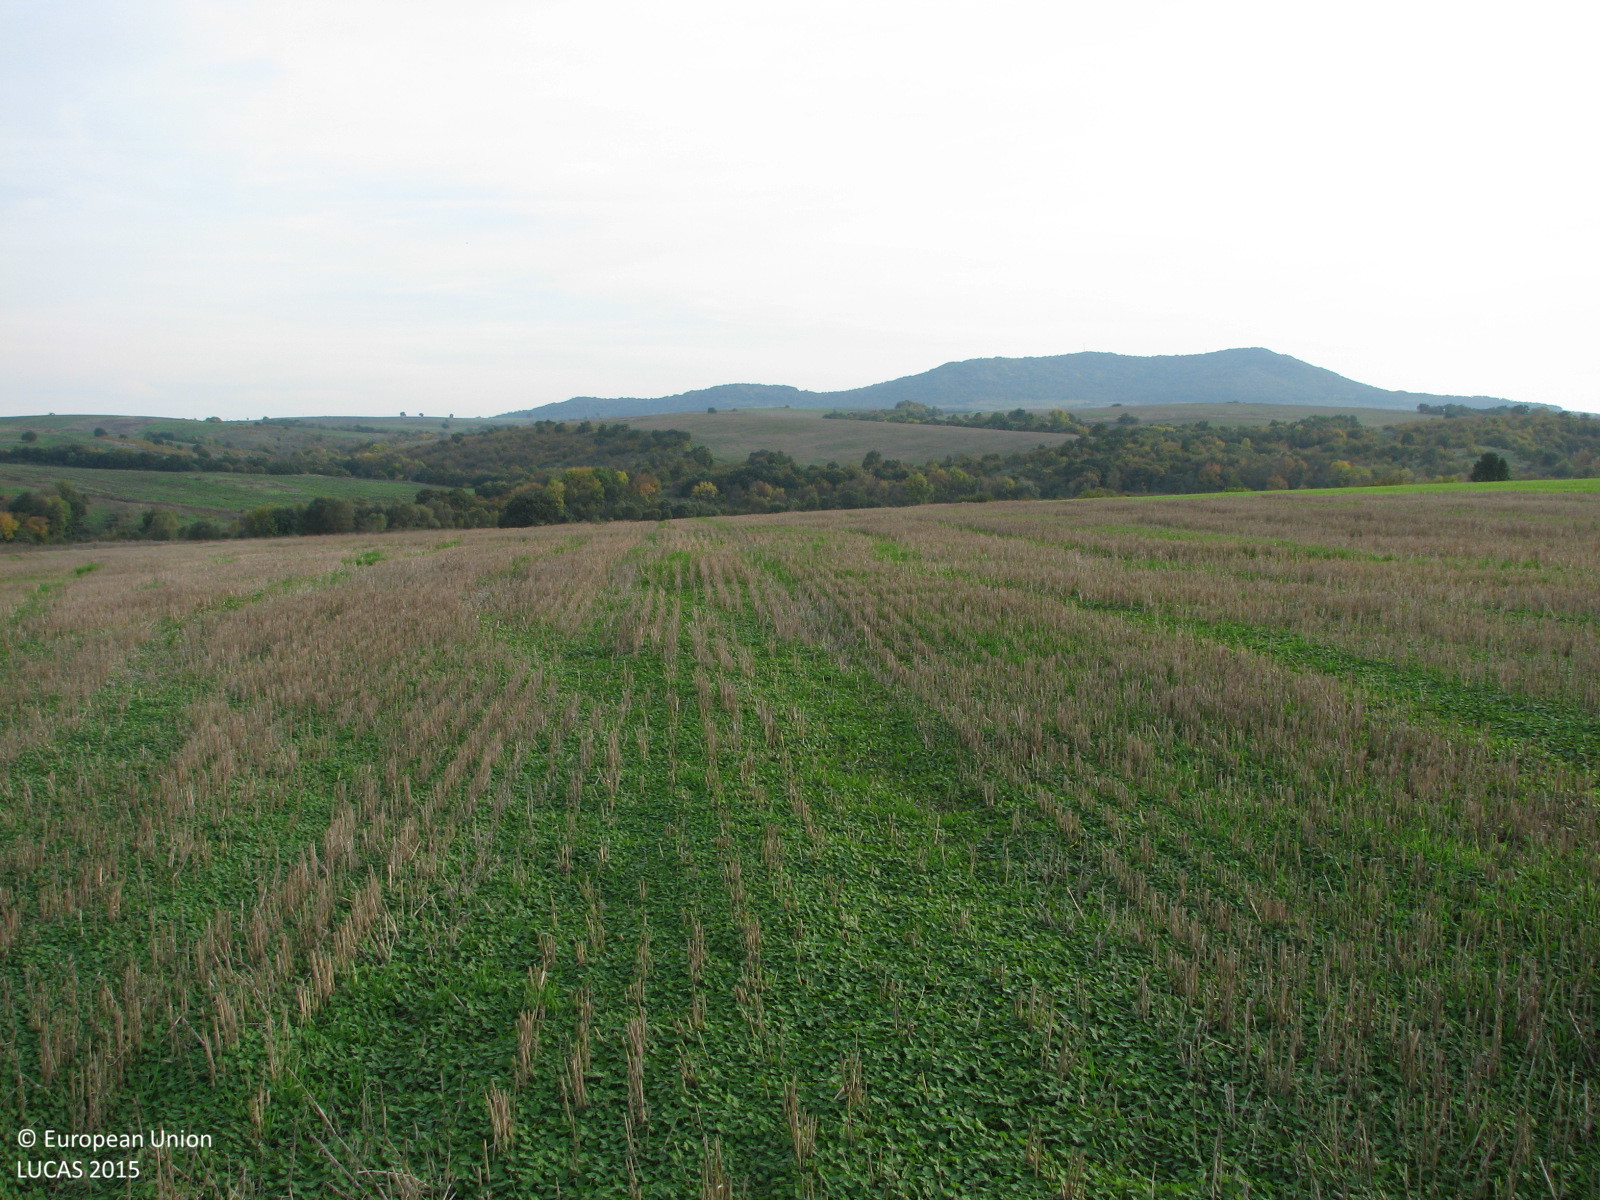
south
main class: Cropland
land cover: Common wheat
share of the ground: 25 - 50 %
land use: Agriculture (excluding fallow land and kitchen gardens)
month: October
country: BG
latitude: 42.4116
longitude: 26.8317
